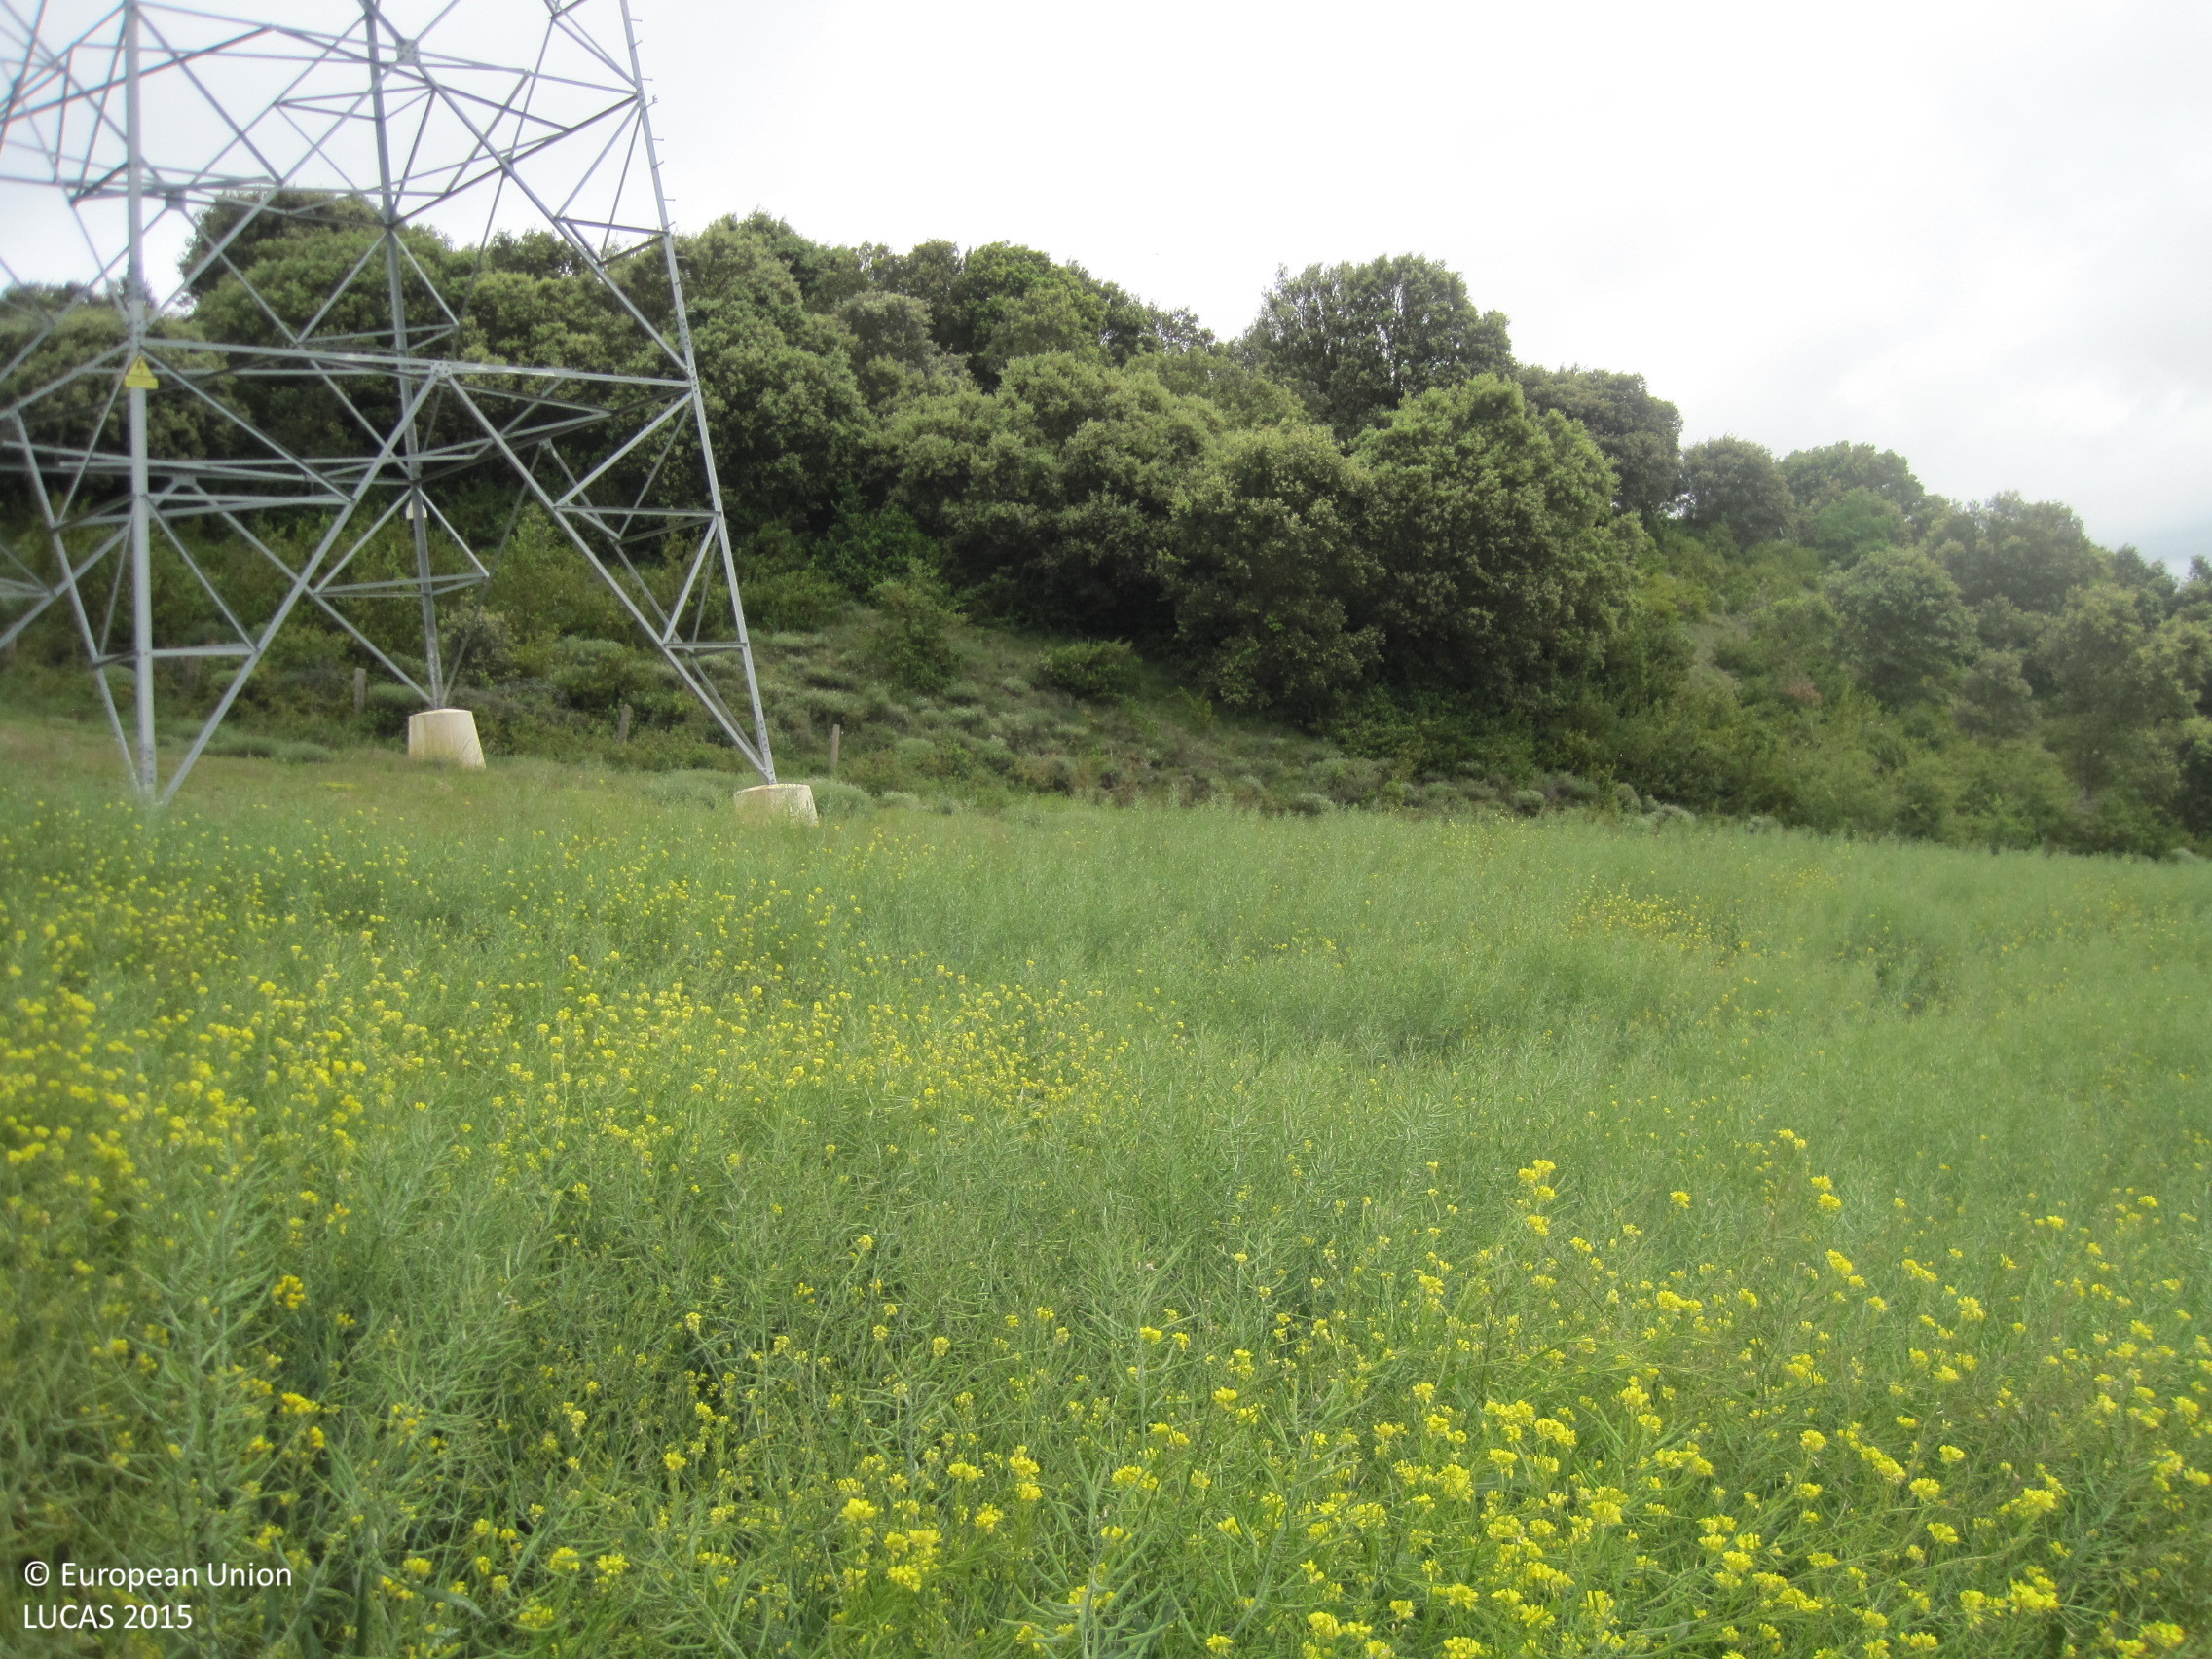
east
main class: Cropland
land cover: Rape and turnip rape
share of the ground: > 75 %
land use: Agriculture (excluding fallow land and kitchen gardens)
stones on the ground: < 10 %
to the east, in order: Rape and turnip rape; Electric lines; Rape and turnip rape; Broadleaved woodland; Shrubland without tree cover; Broadleaved woodland; Shrubland with sparse tree cover
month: May
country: ES
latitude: 42.7235
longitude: -1.6768
